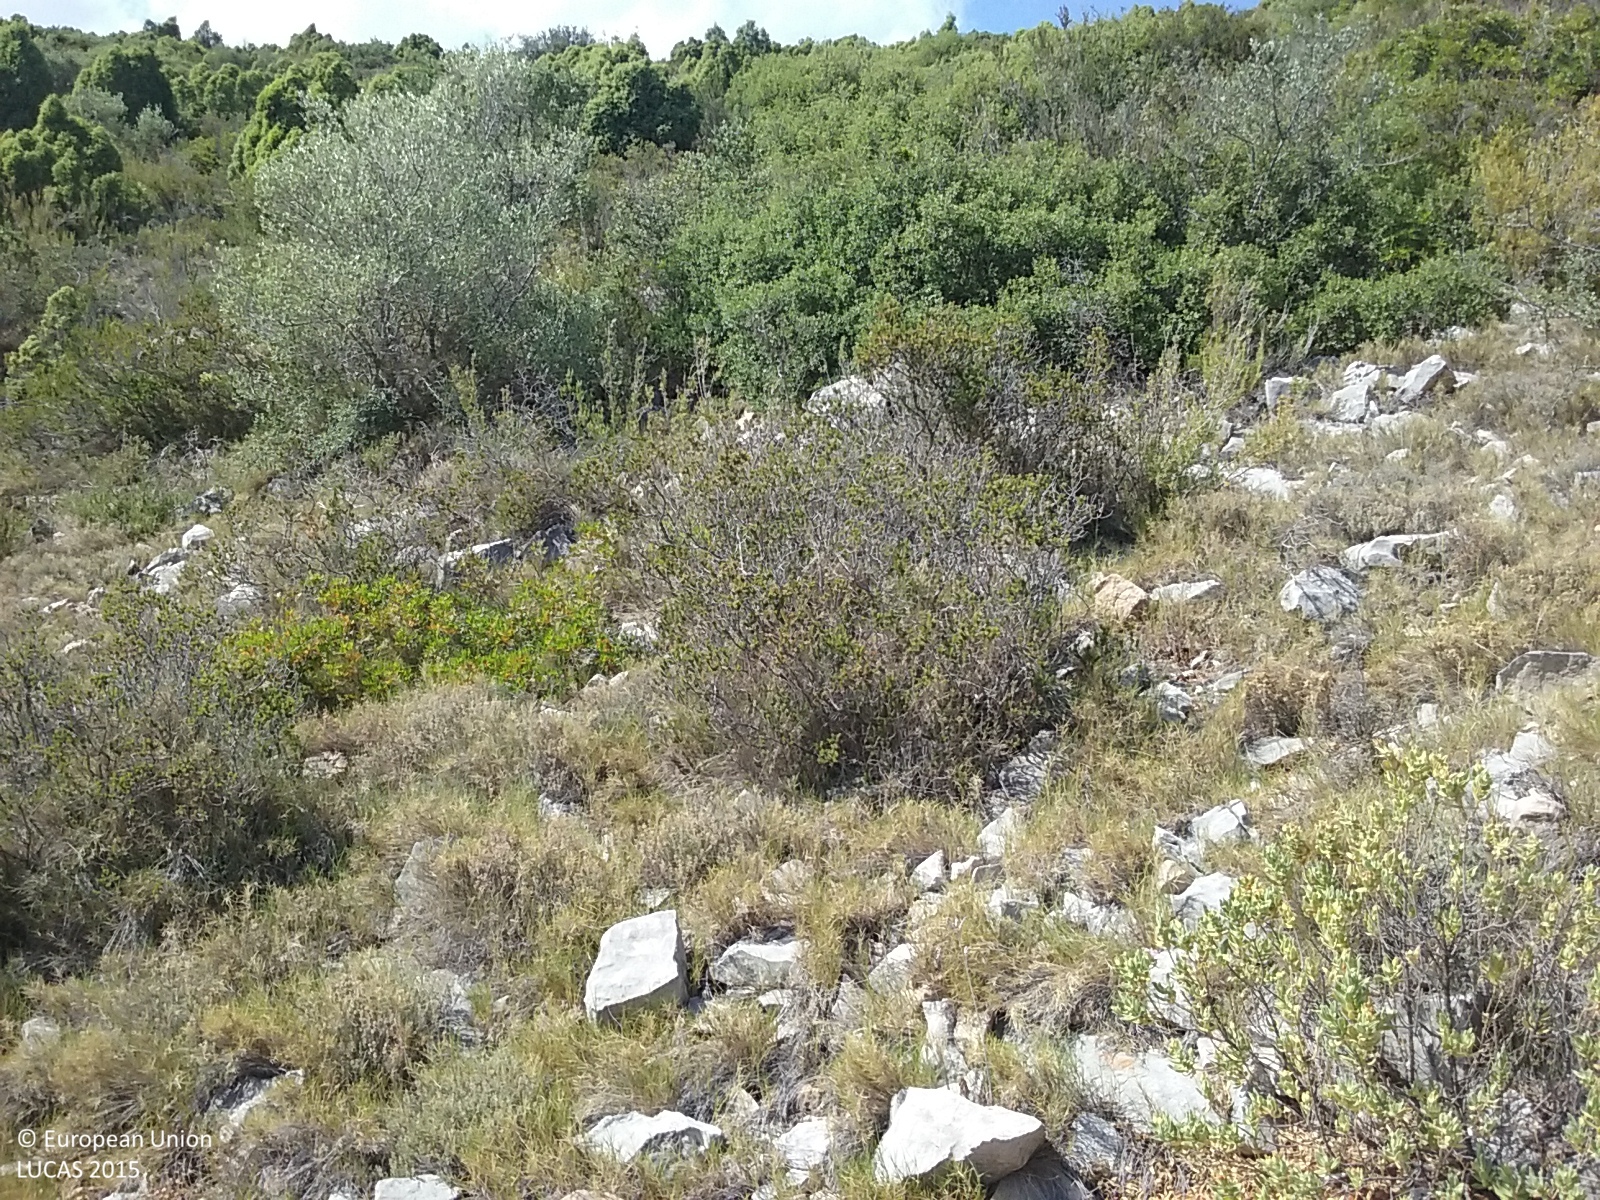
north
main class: Shrubland
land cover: Shrubland with sparse tree cover
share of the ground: > 75 %
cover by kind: shrubs 70 %, herbaceous plants 20 %, broadleaved forest trees 5 %
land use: Semi-natural and natural areas not in use
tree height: < 5 m
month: May
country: ES
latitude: 40.2666
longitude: 0.0131
